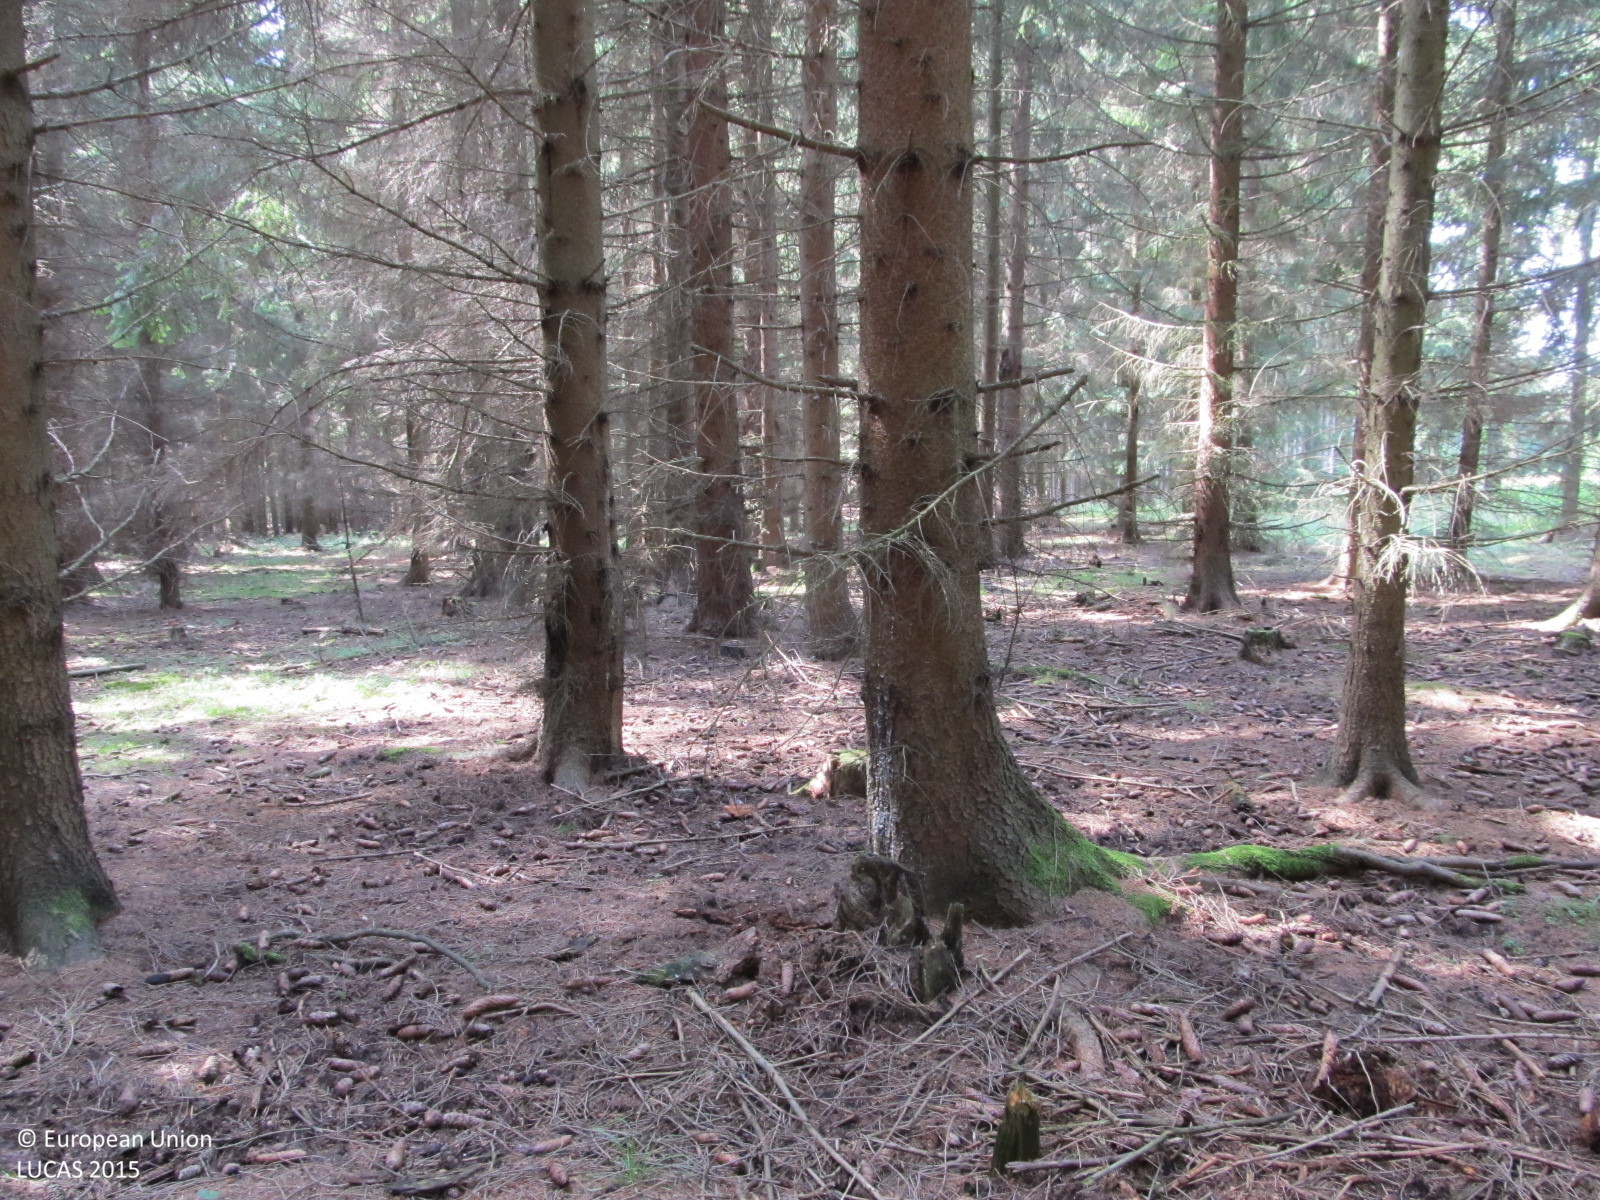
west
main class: Woodland
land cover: Spruce dominated coniferous woodland
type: hemiboreal forest and nemoral coniferous forest and mixed broadleaved-coniferous forest
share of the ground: > 75 %
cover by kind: coniferous forest trees 80 %, unconsolidated bare surface 20 %
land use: Forestry
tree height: > 5 m
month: August
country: AT
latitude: 48.7337
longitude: 15.5369
